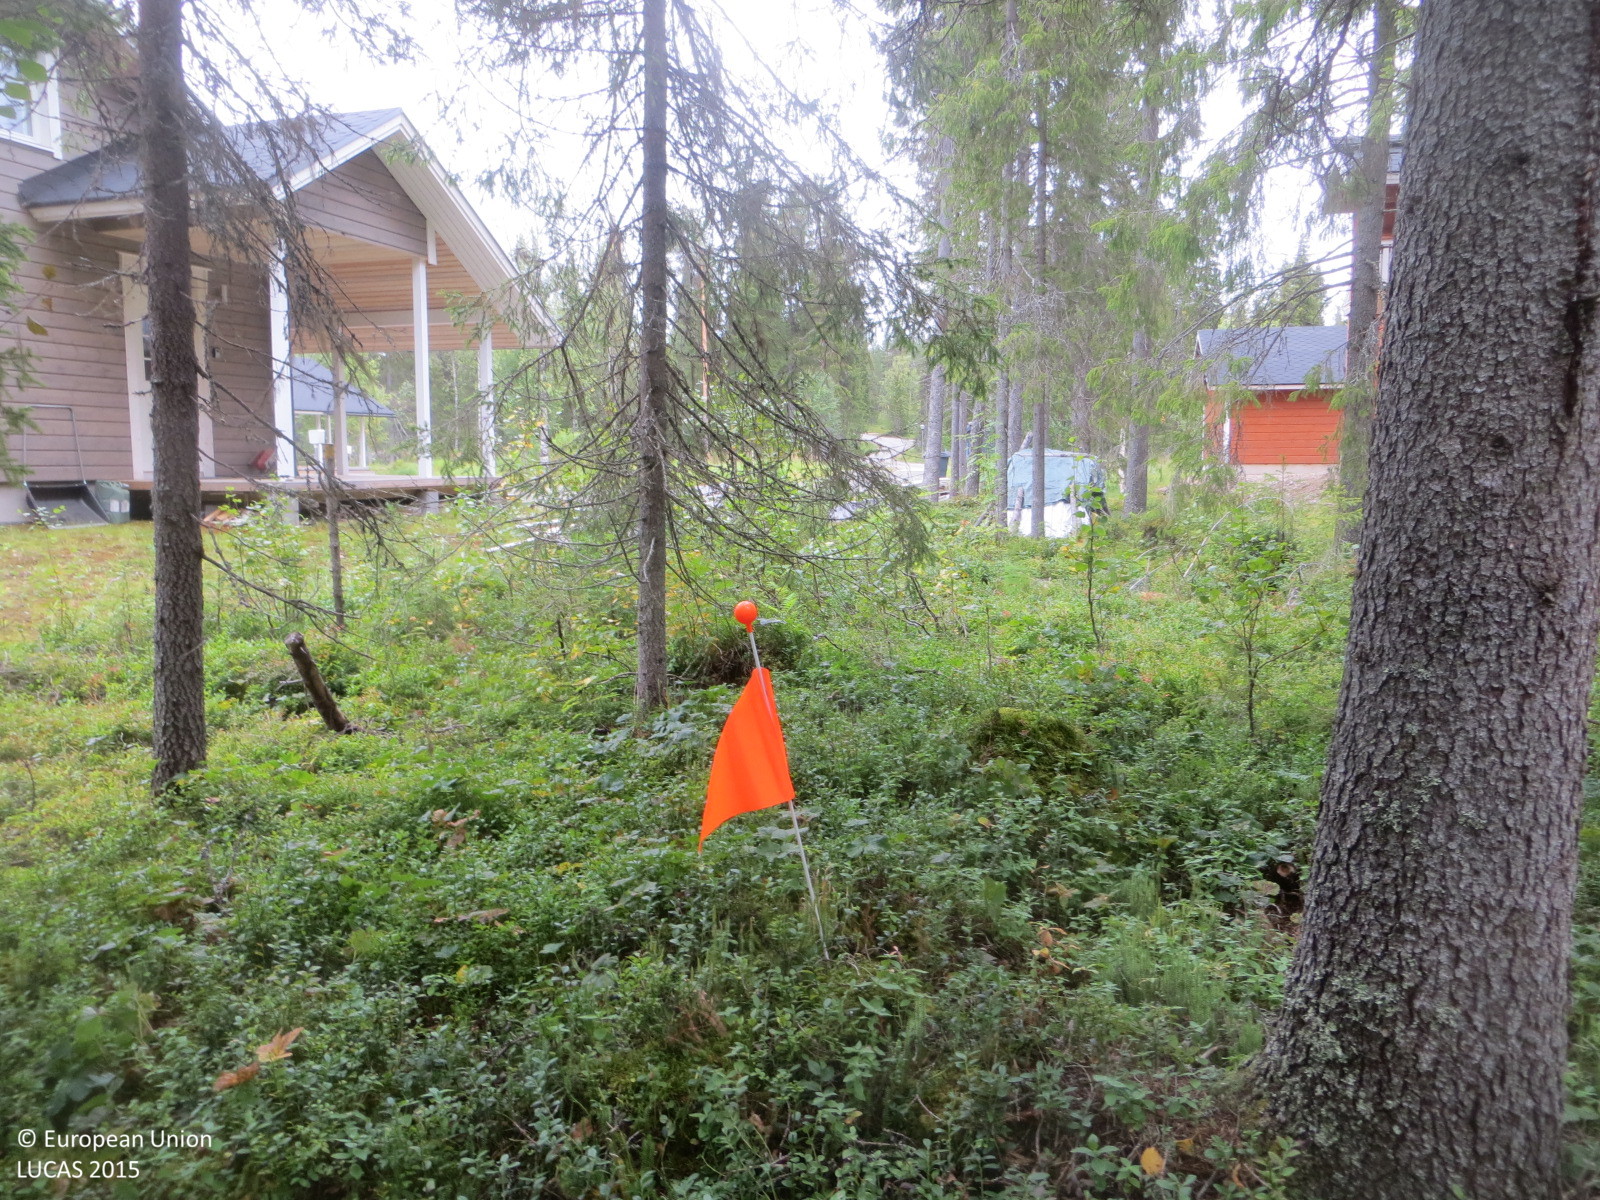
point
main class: Woodland
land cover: Spruce dominated coniferous woodland
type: boreal forest
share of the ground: > 75 %
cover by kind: coniferous forest trees 75 %, shrubs 25 %
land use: Forestry
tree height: > 5 m
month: August
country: FI
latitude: 67.5331
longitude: 24.2600
